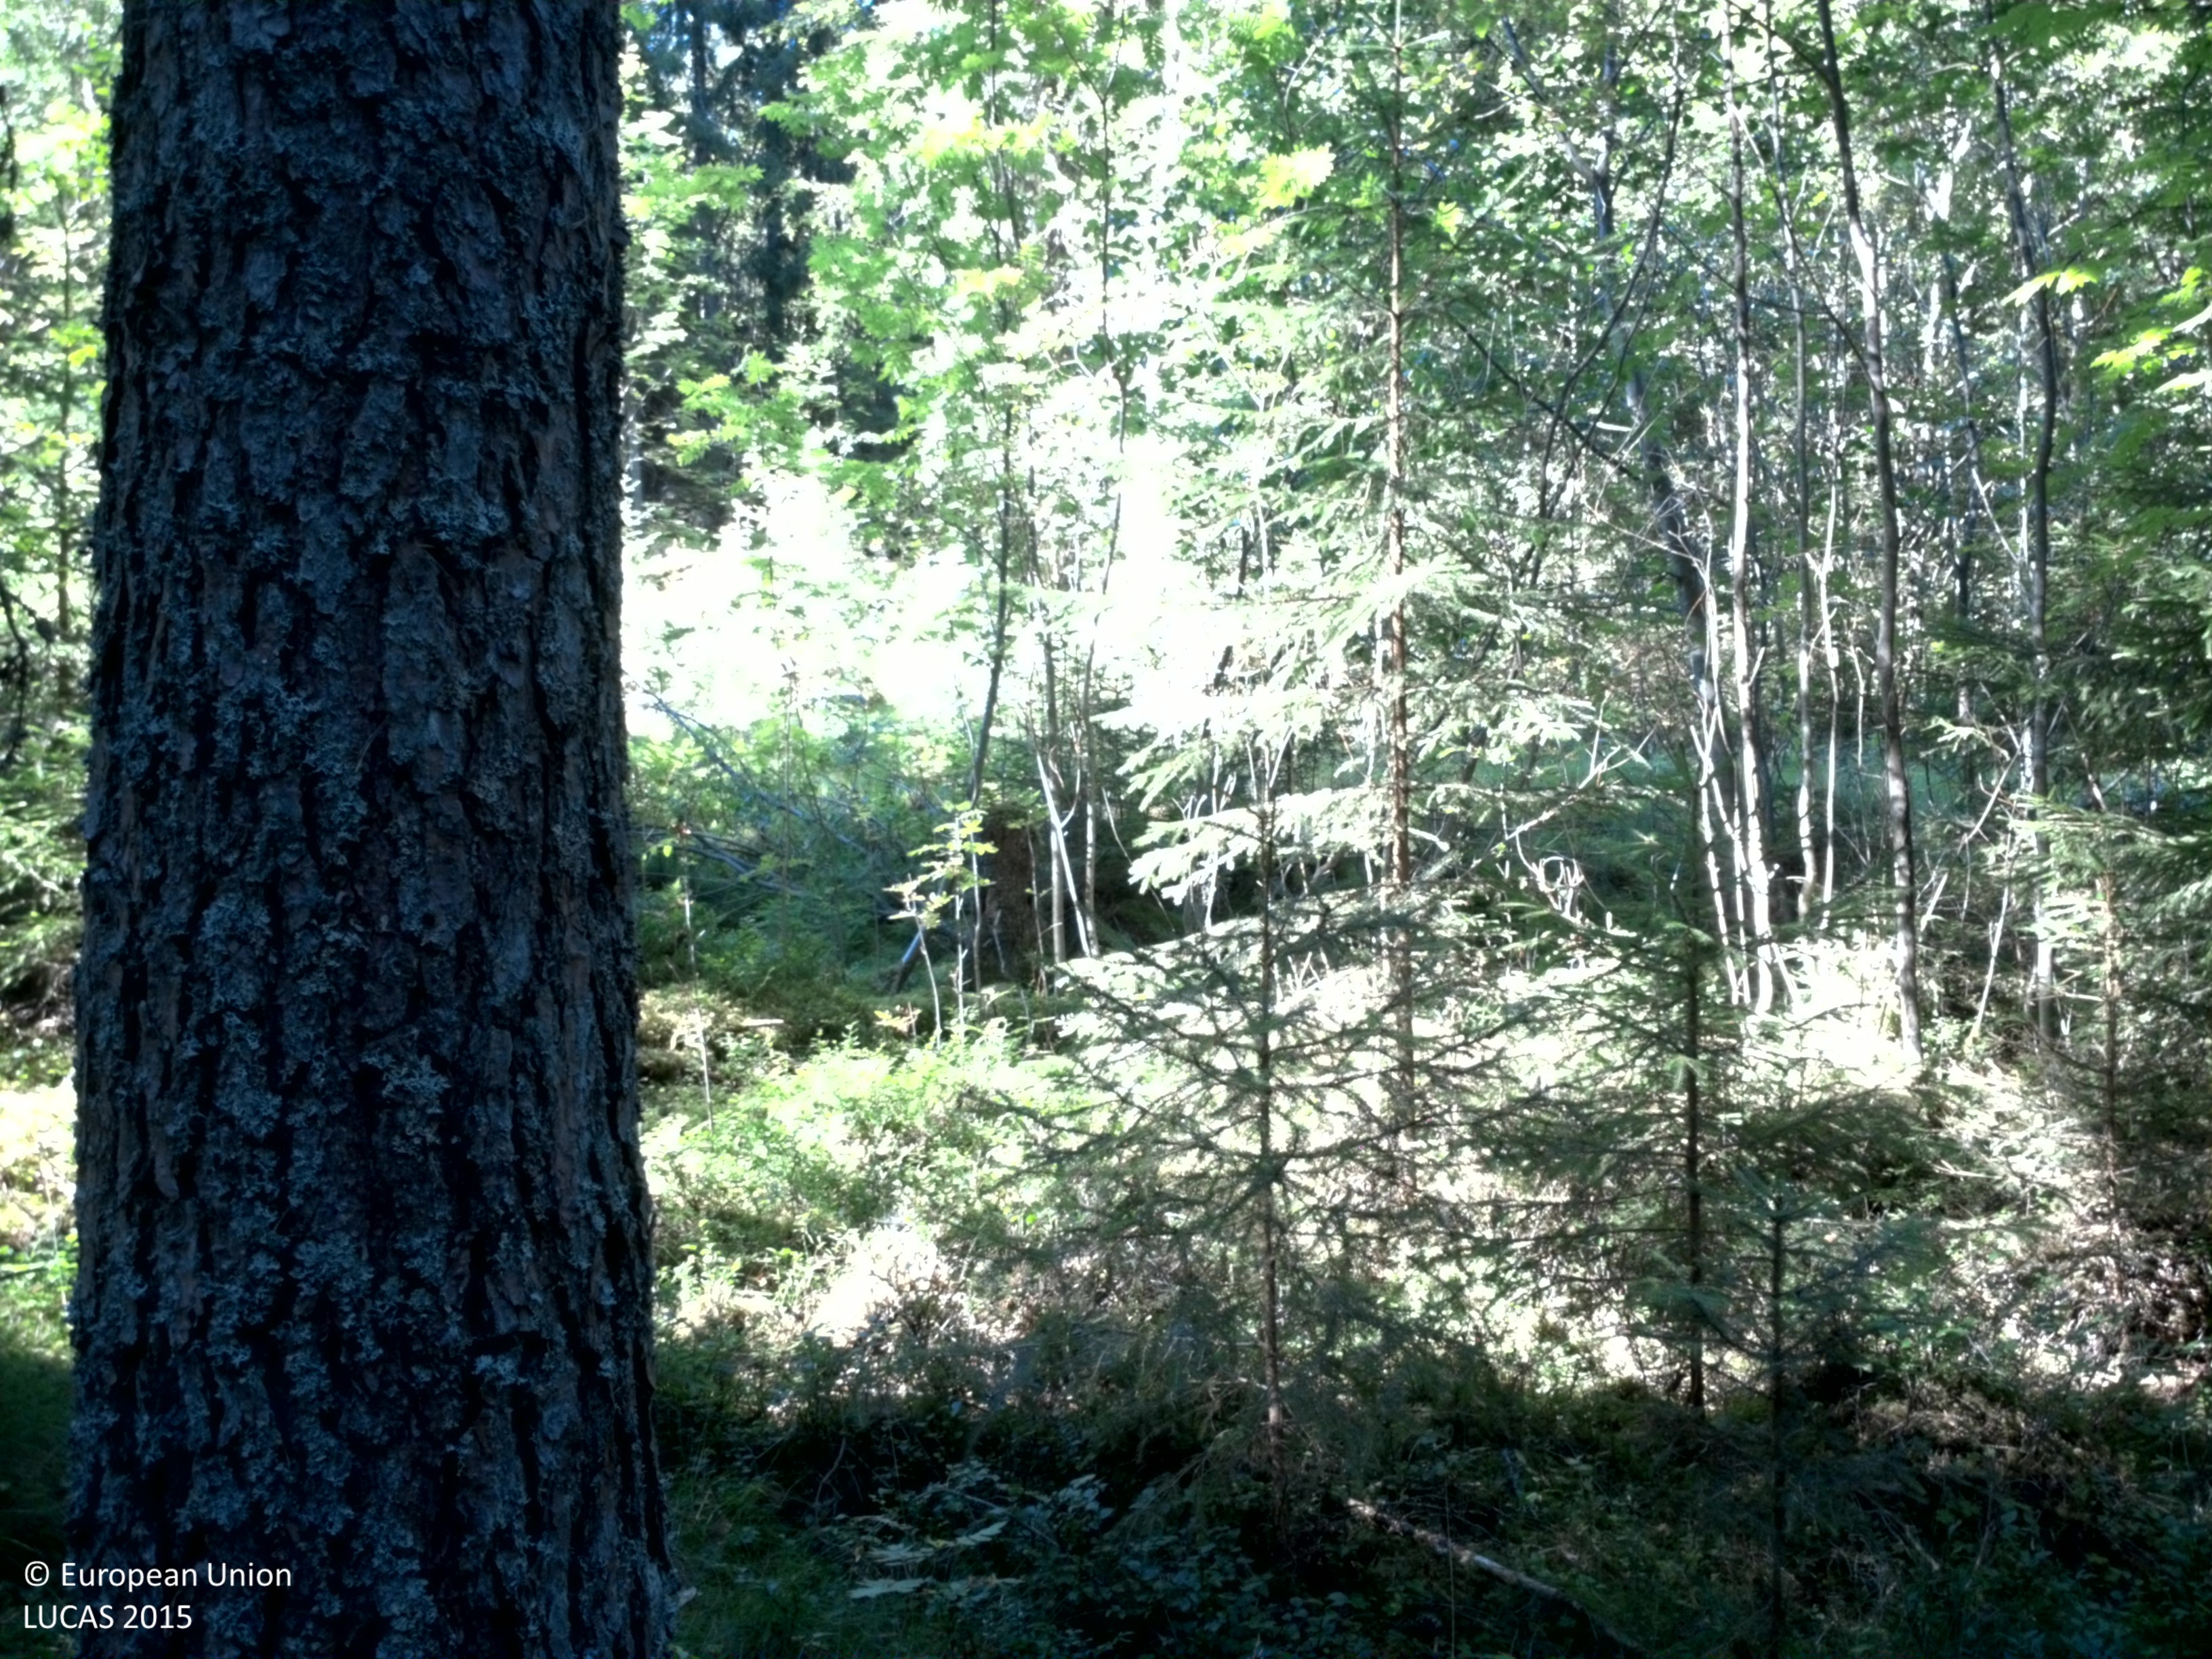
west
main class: Woodland
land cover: Spruce dominated coniferous woodland
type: boreal forest
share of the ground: 50 - 75 %
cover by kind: coniferous forest trees 65 %, lichens and mosses 20 %, broadleaved forest trees 5 %, shrubs 5 %, herbaceous plants 5 %
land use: Forestry
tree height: > 5 m
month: August
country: SE
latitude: 60.1183
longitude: 13.5354
